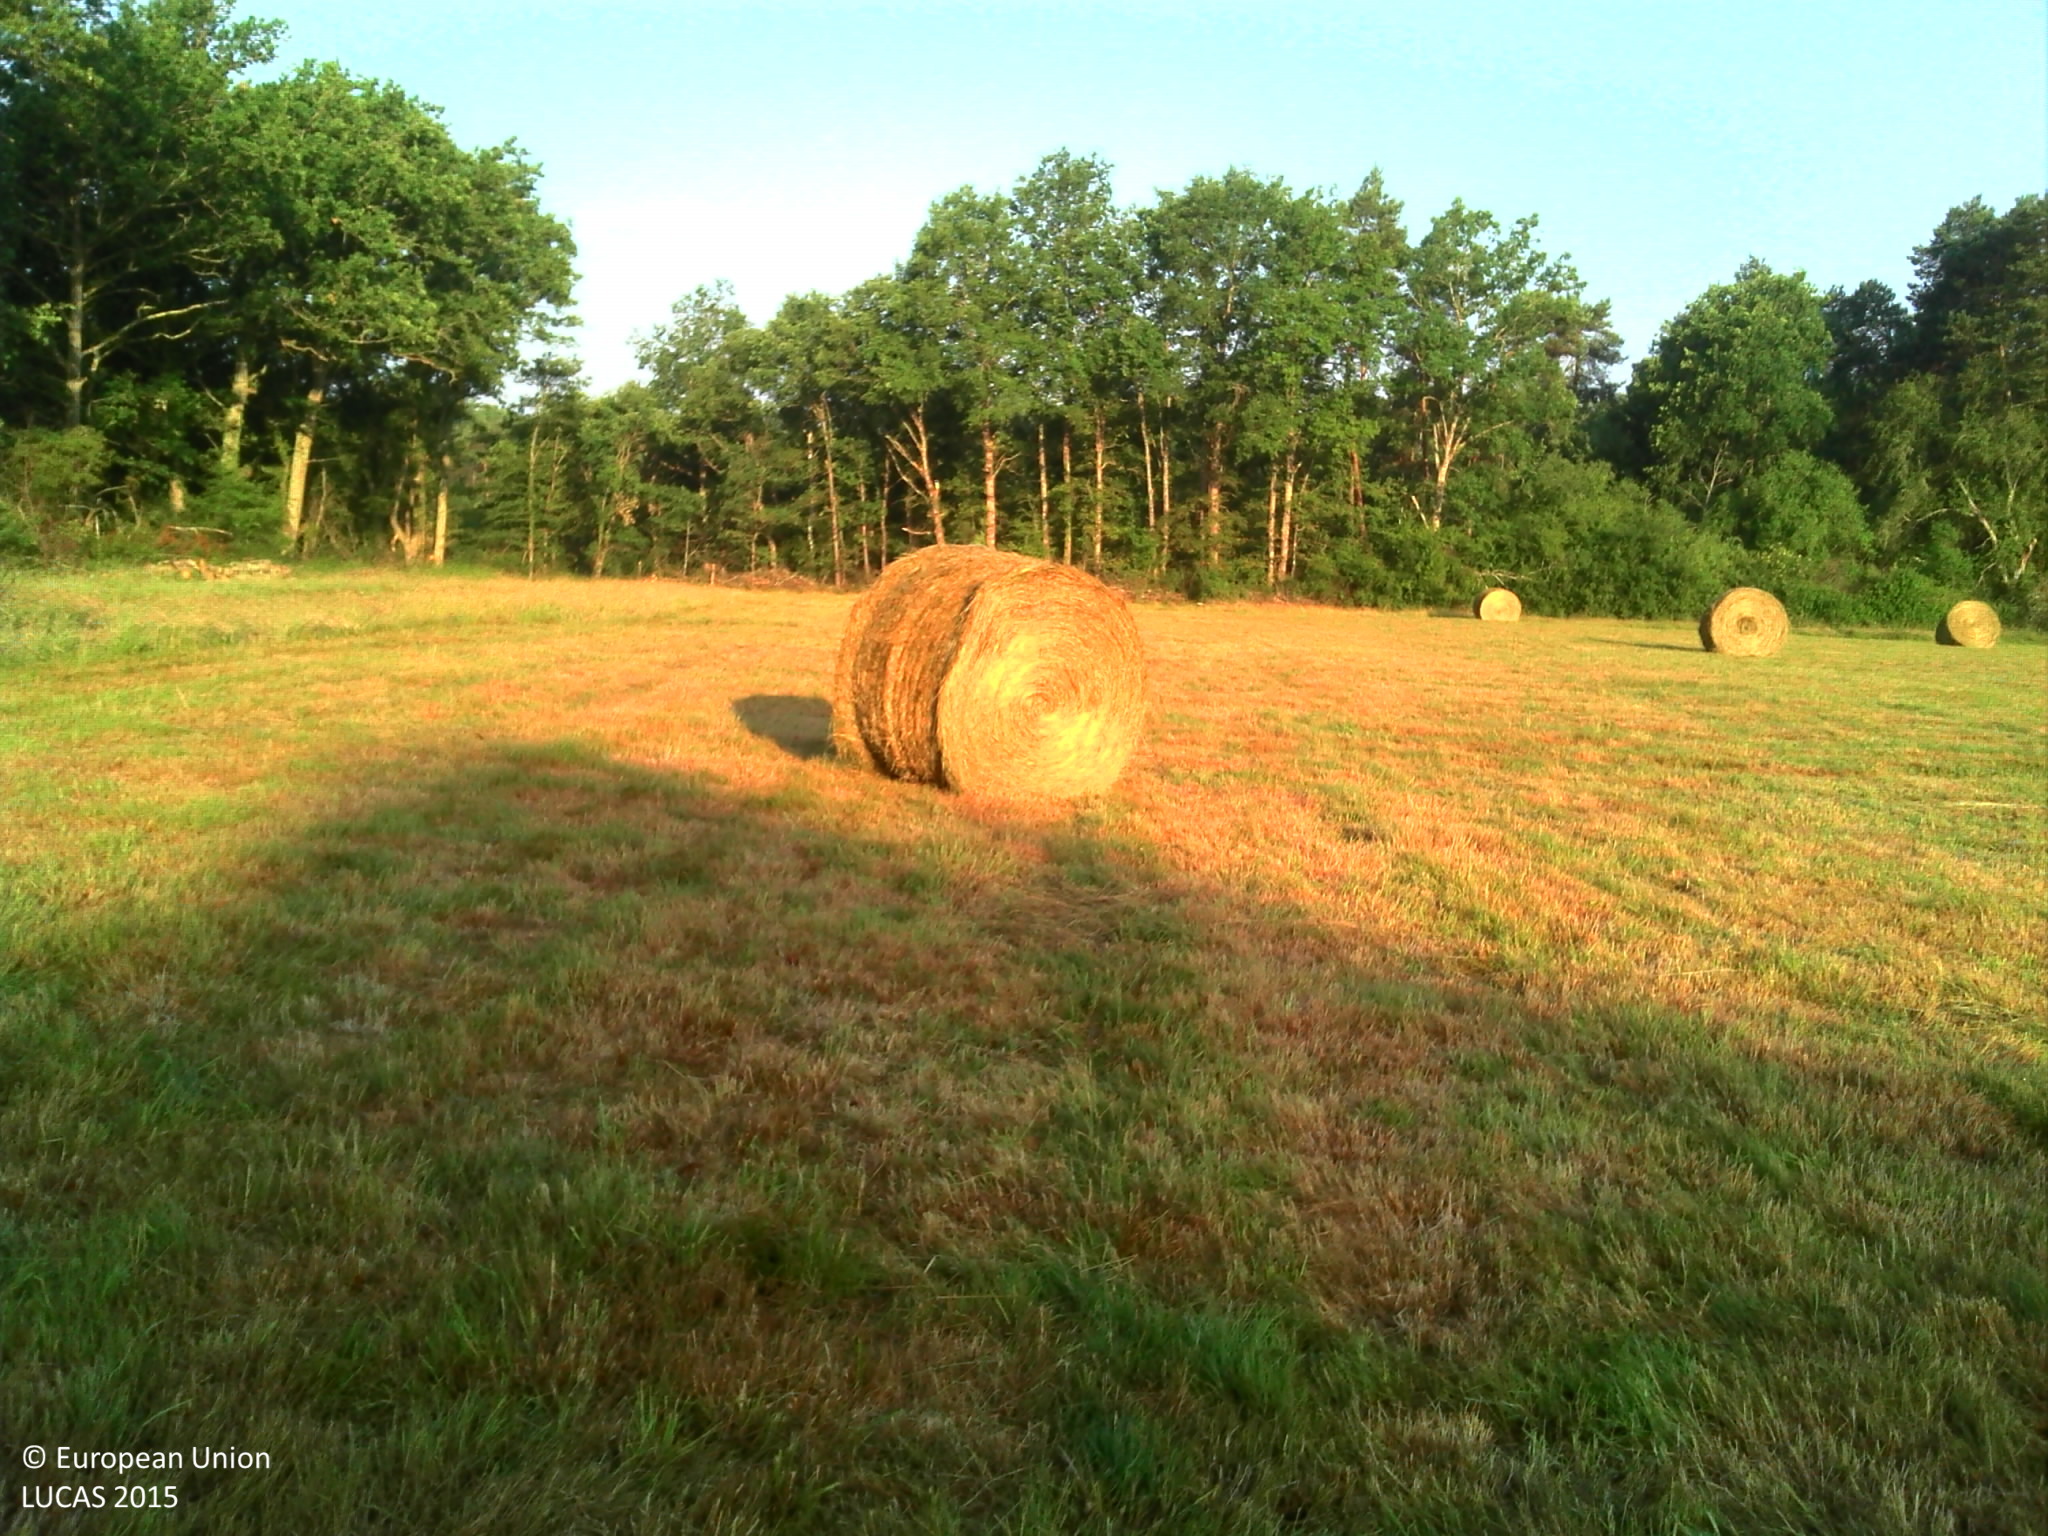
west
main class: Grassland
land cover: Grassland without tree/shrub cover
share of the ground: > 75 %
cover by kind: herbaceous plants 100 %
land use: Agriculture (excluding fallow land and kitchen gardens)
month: June
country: FR
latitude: 46.7850
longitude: 2.6464
